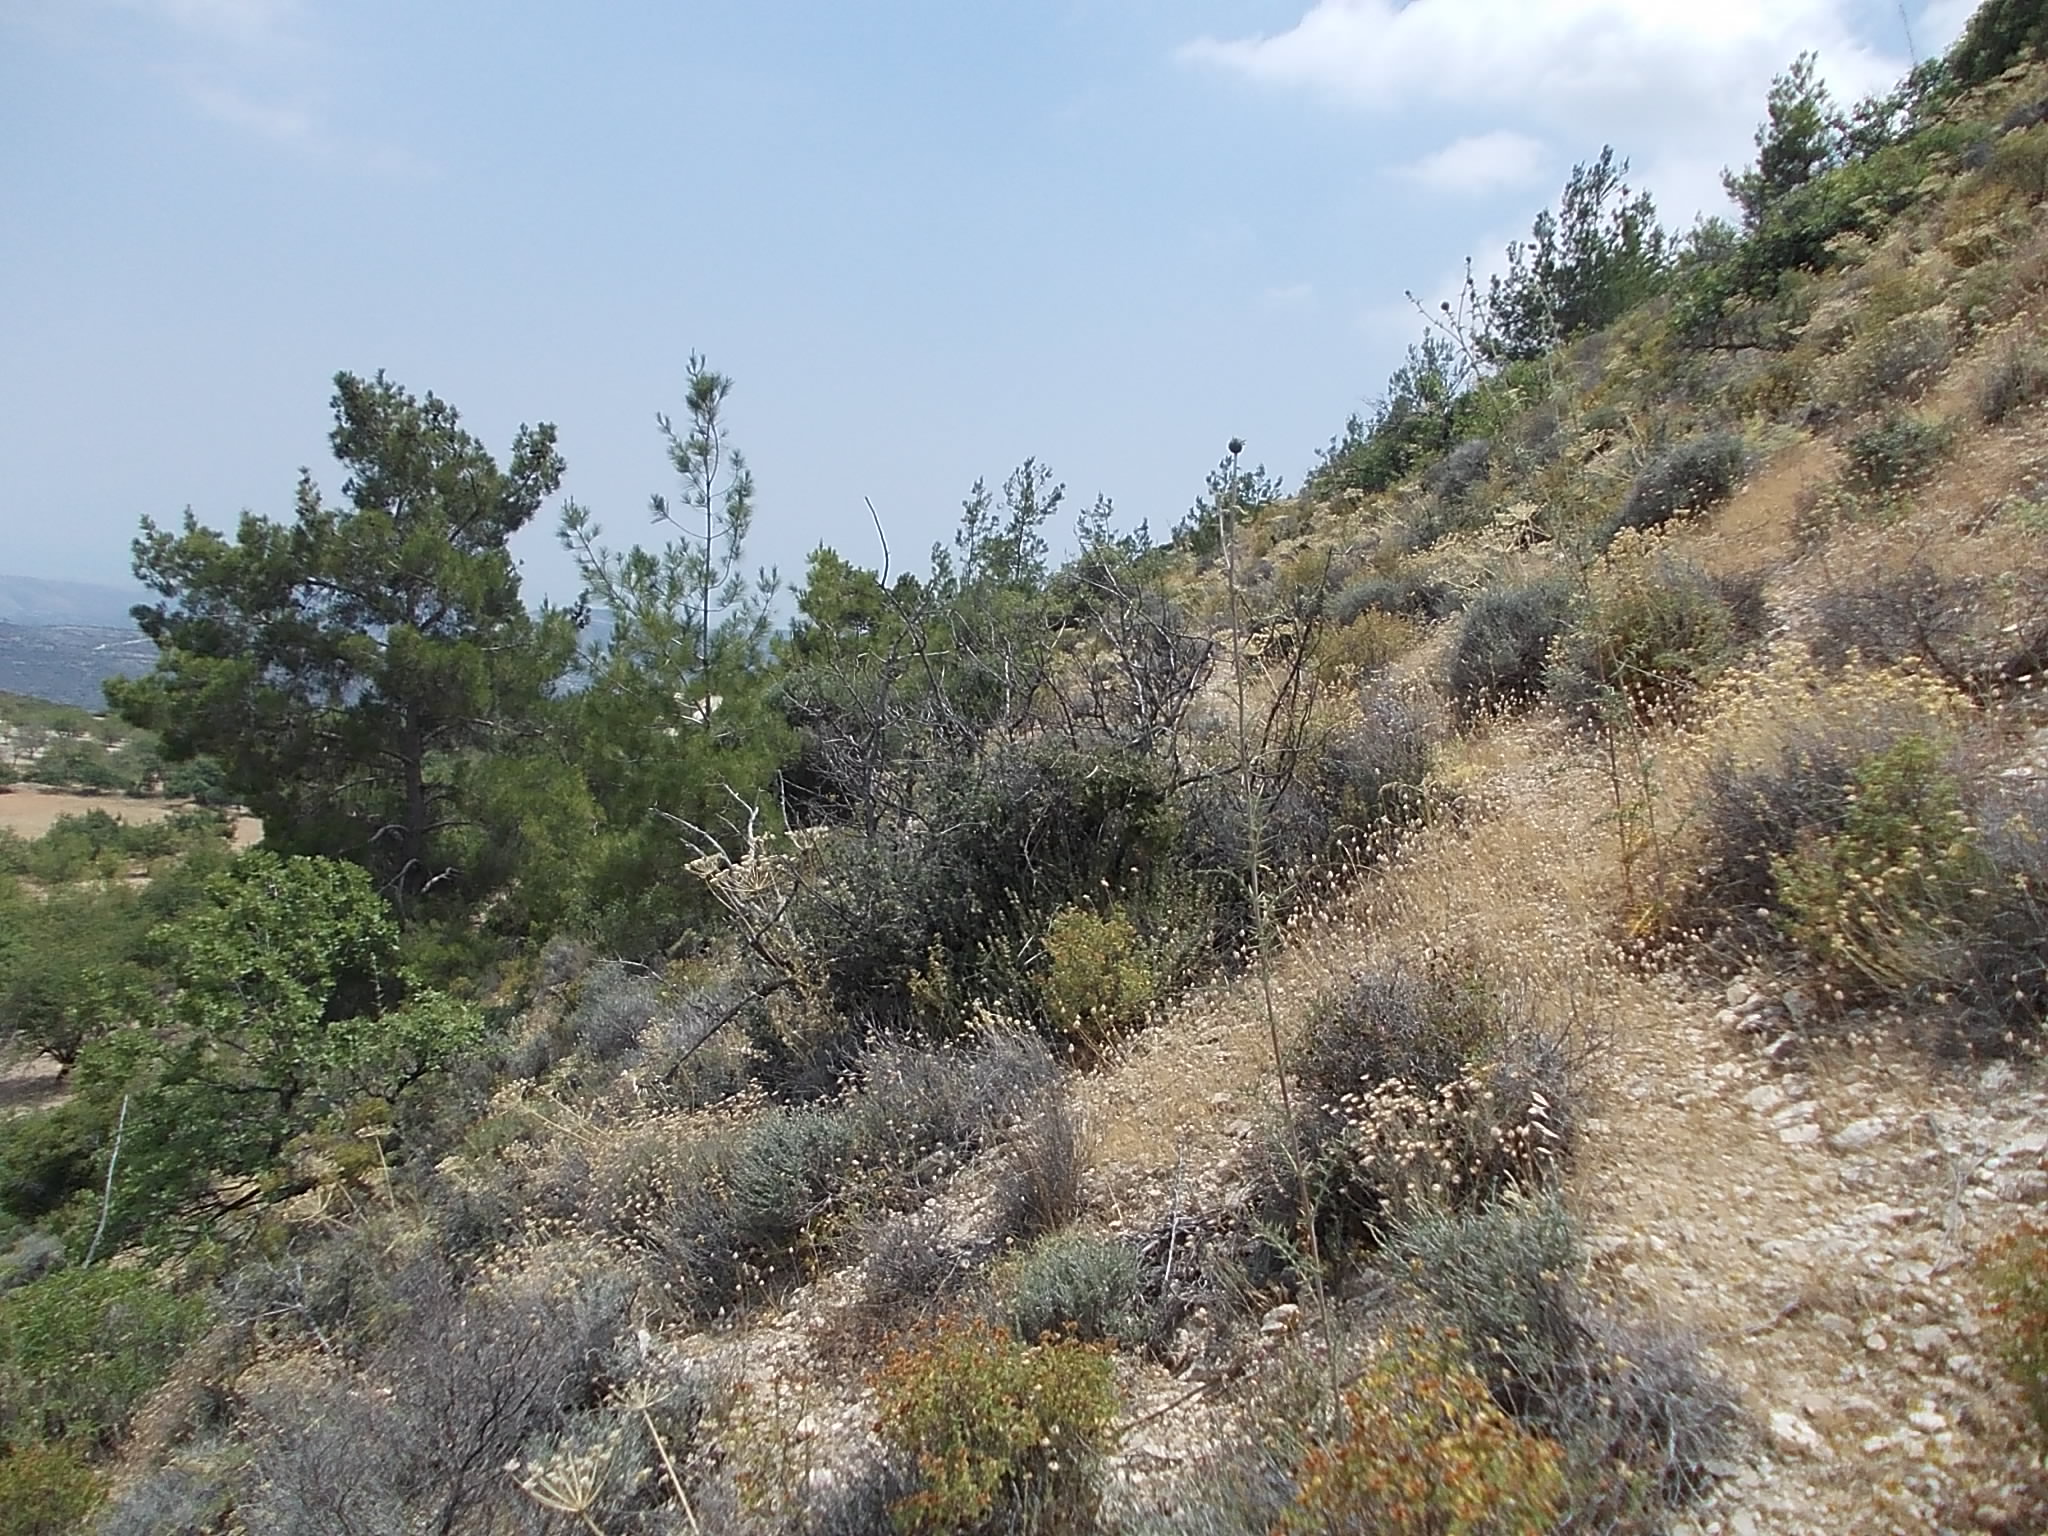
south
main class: Shrubland
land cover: Shrubland with sparse tree cover
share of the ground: 50 - 75 %
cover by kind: shrubs 55 %, unconsolidated bare surface 25 %, herbaceous plants 15 %, broadleaved forest trees 5 %
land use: Semi-natural and natural areas not in use
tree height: < 5 m
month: June
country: CY
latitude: 34.8104
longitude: 32.9355
